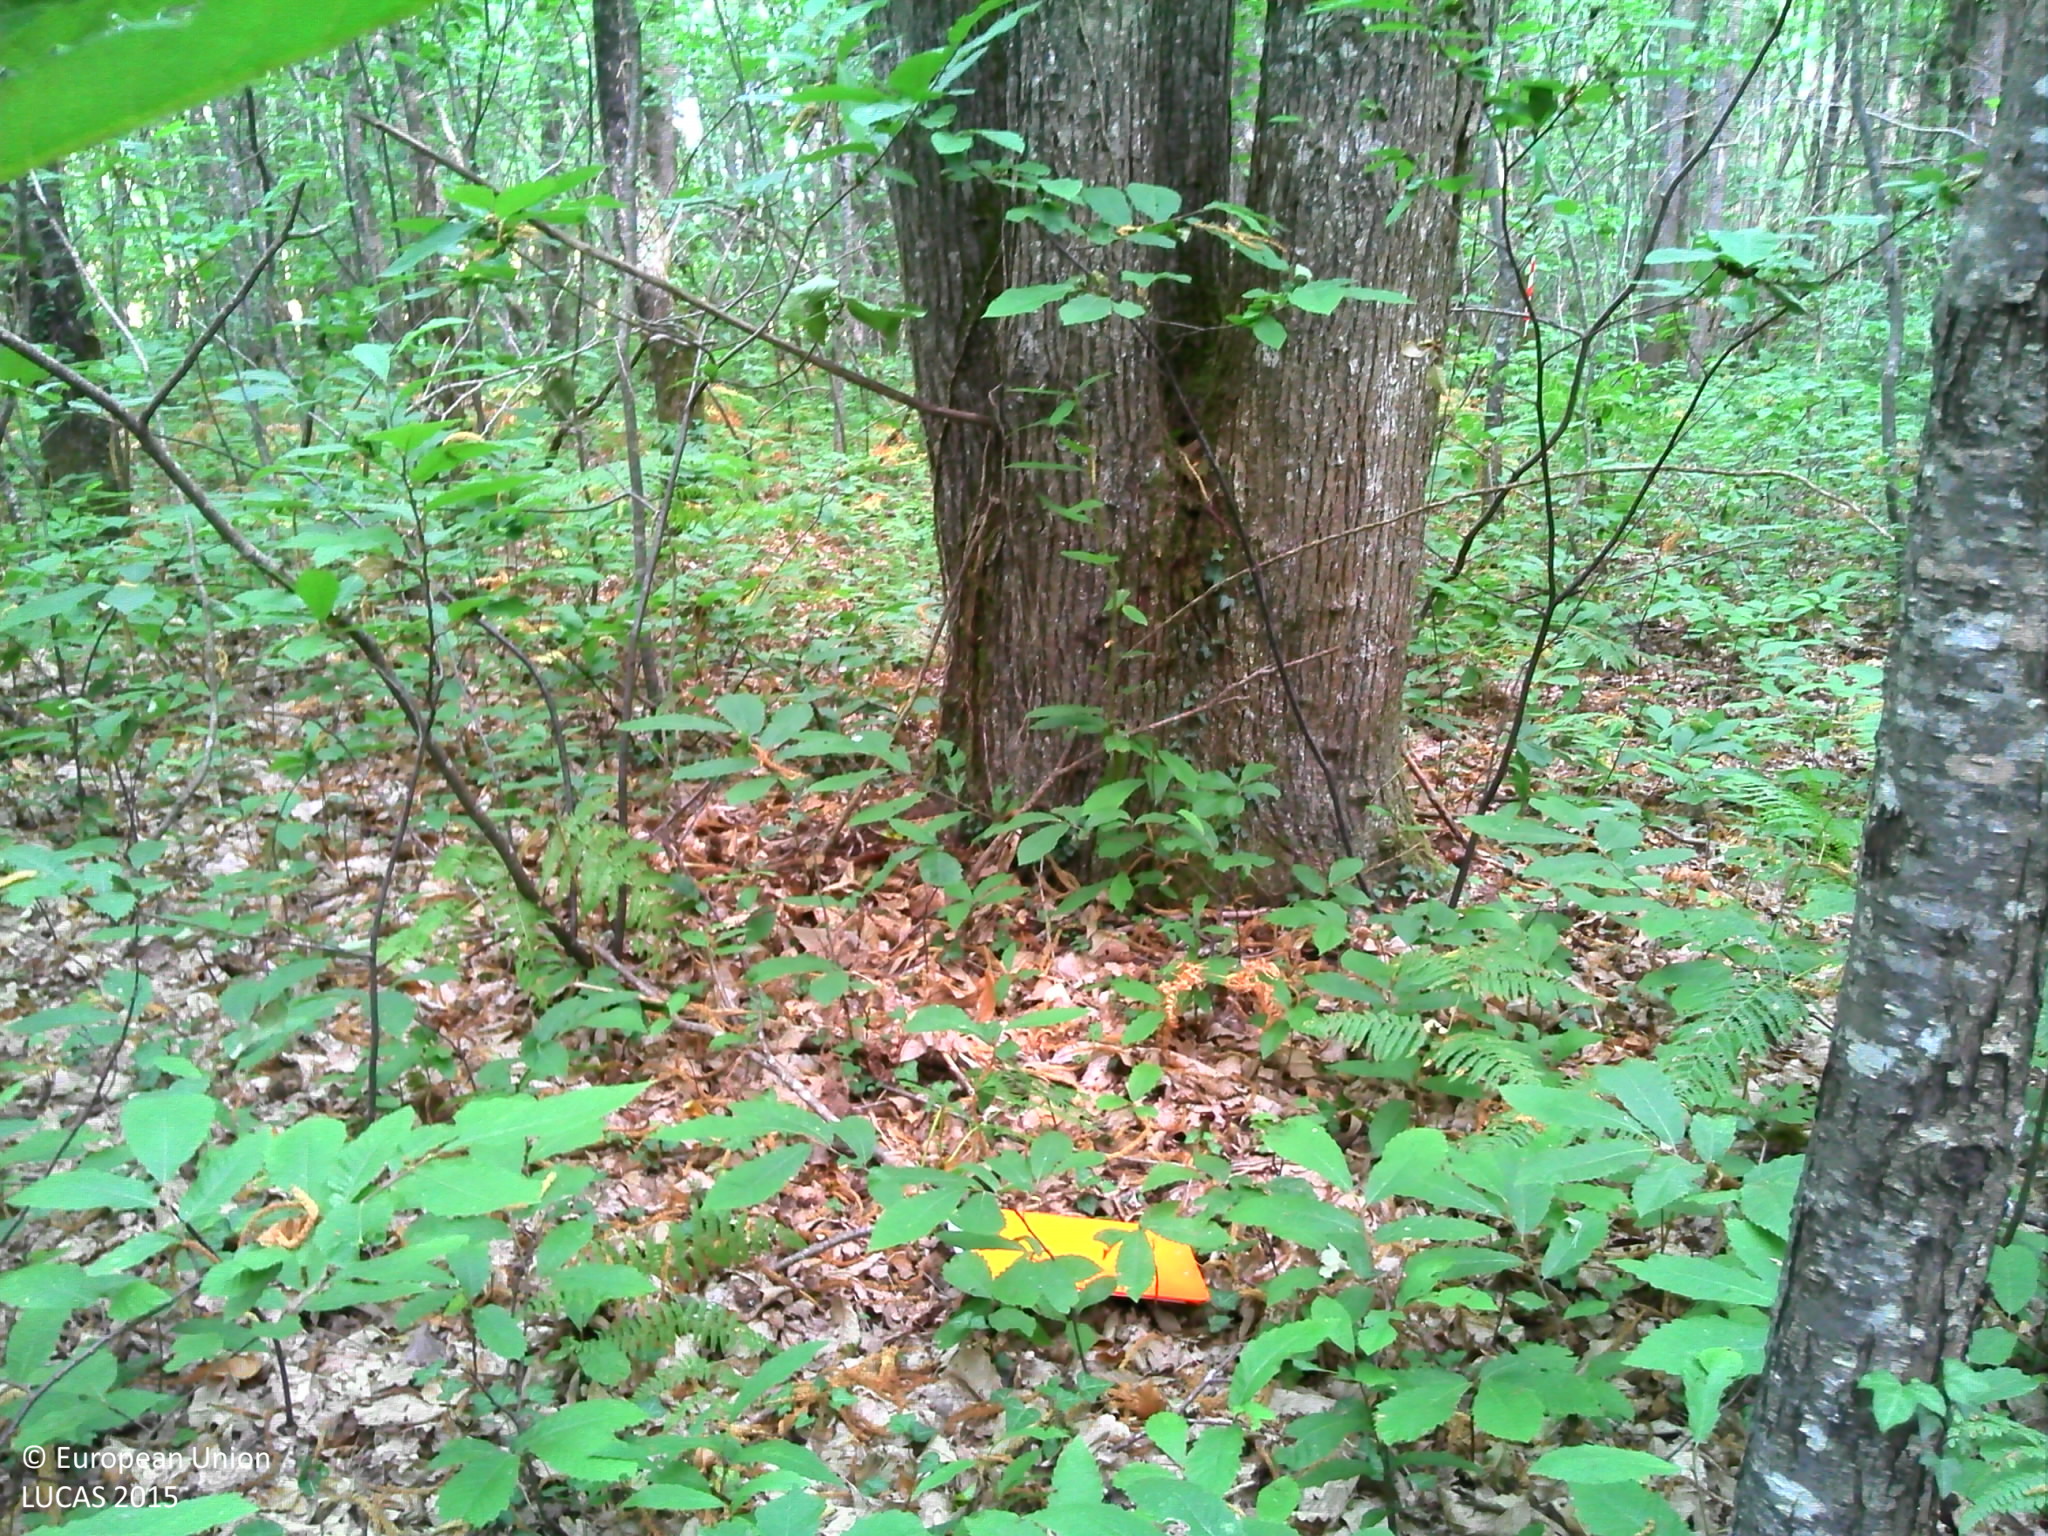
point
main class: Woodland
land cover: Broadleaved woodland
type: thermophilous deciduous forest
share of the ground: > 75 %
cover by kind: broadleaved forest trees 80 %, herbaceous plants 10 %, shrubs 5 %, lichens and mosses 5 %
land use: Forestry
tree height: > 5 m
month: July
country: FR
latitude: 44.9906
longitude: 0.7703
